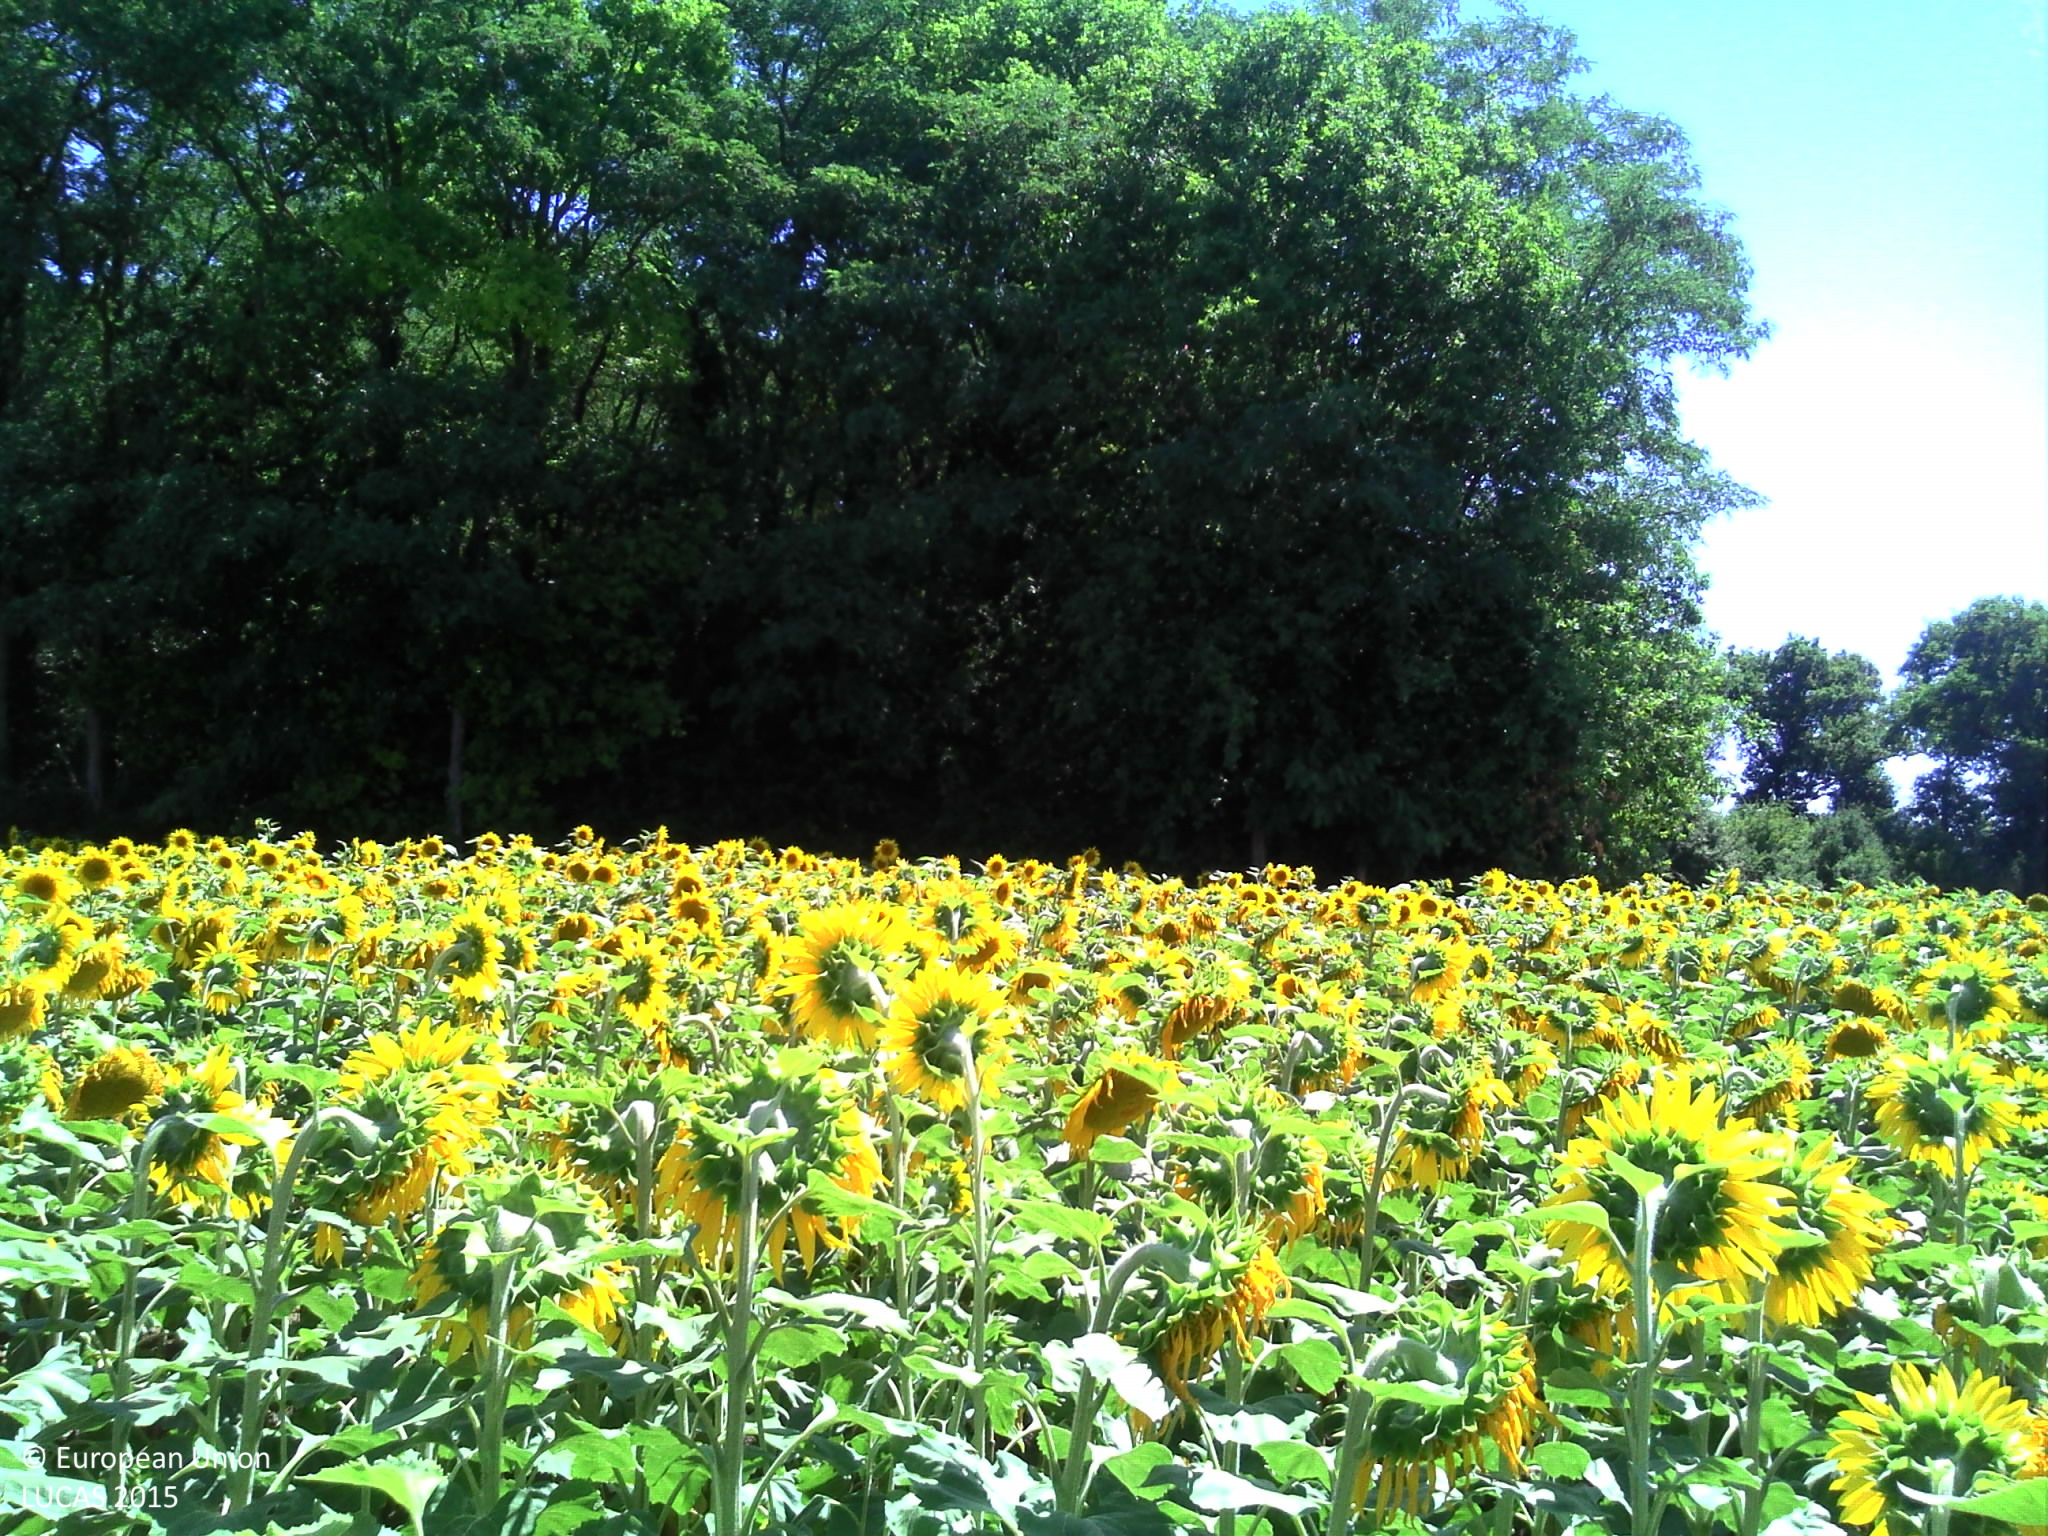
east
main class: Cropland
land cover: Sunflower
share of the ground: > 75 %
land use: Agriculture (excluding fallow land and kitchen gardens)
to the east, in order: Sunflower; Grassland without tree/shrub cover; Broadleaved woodland; Grassland without tree/shrub cover
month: July
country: FR
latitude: 47.9914
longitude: 2.5806
